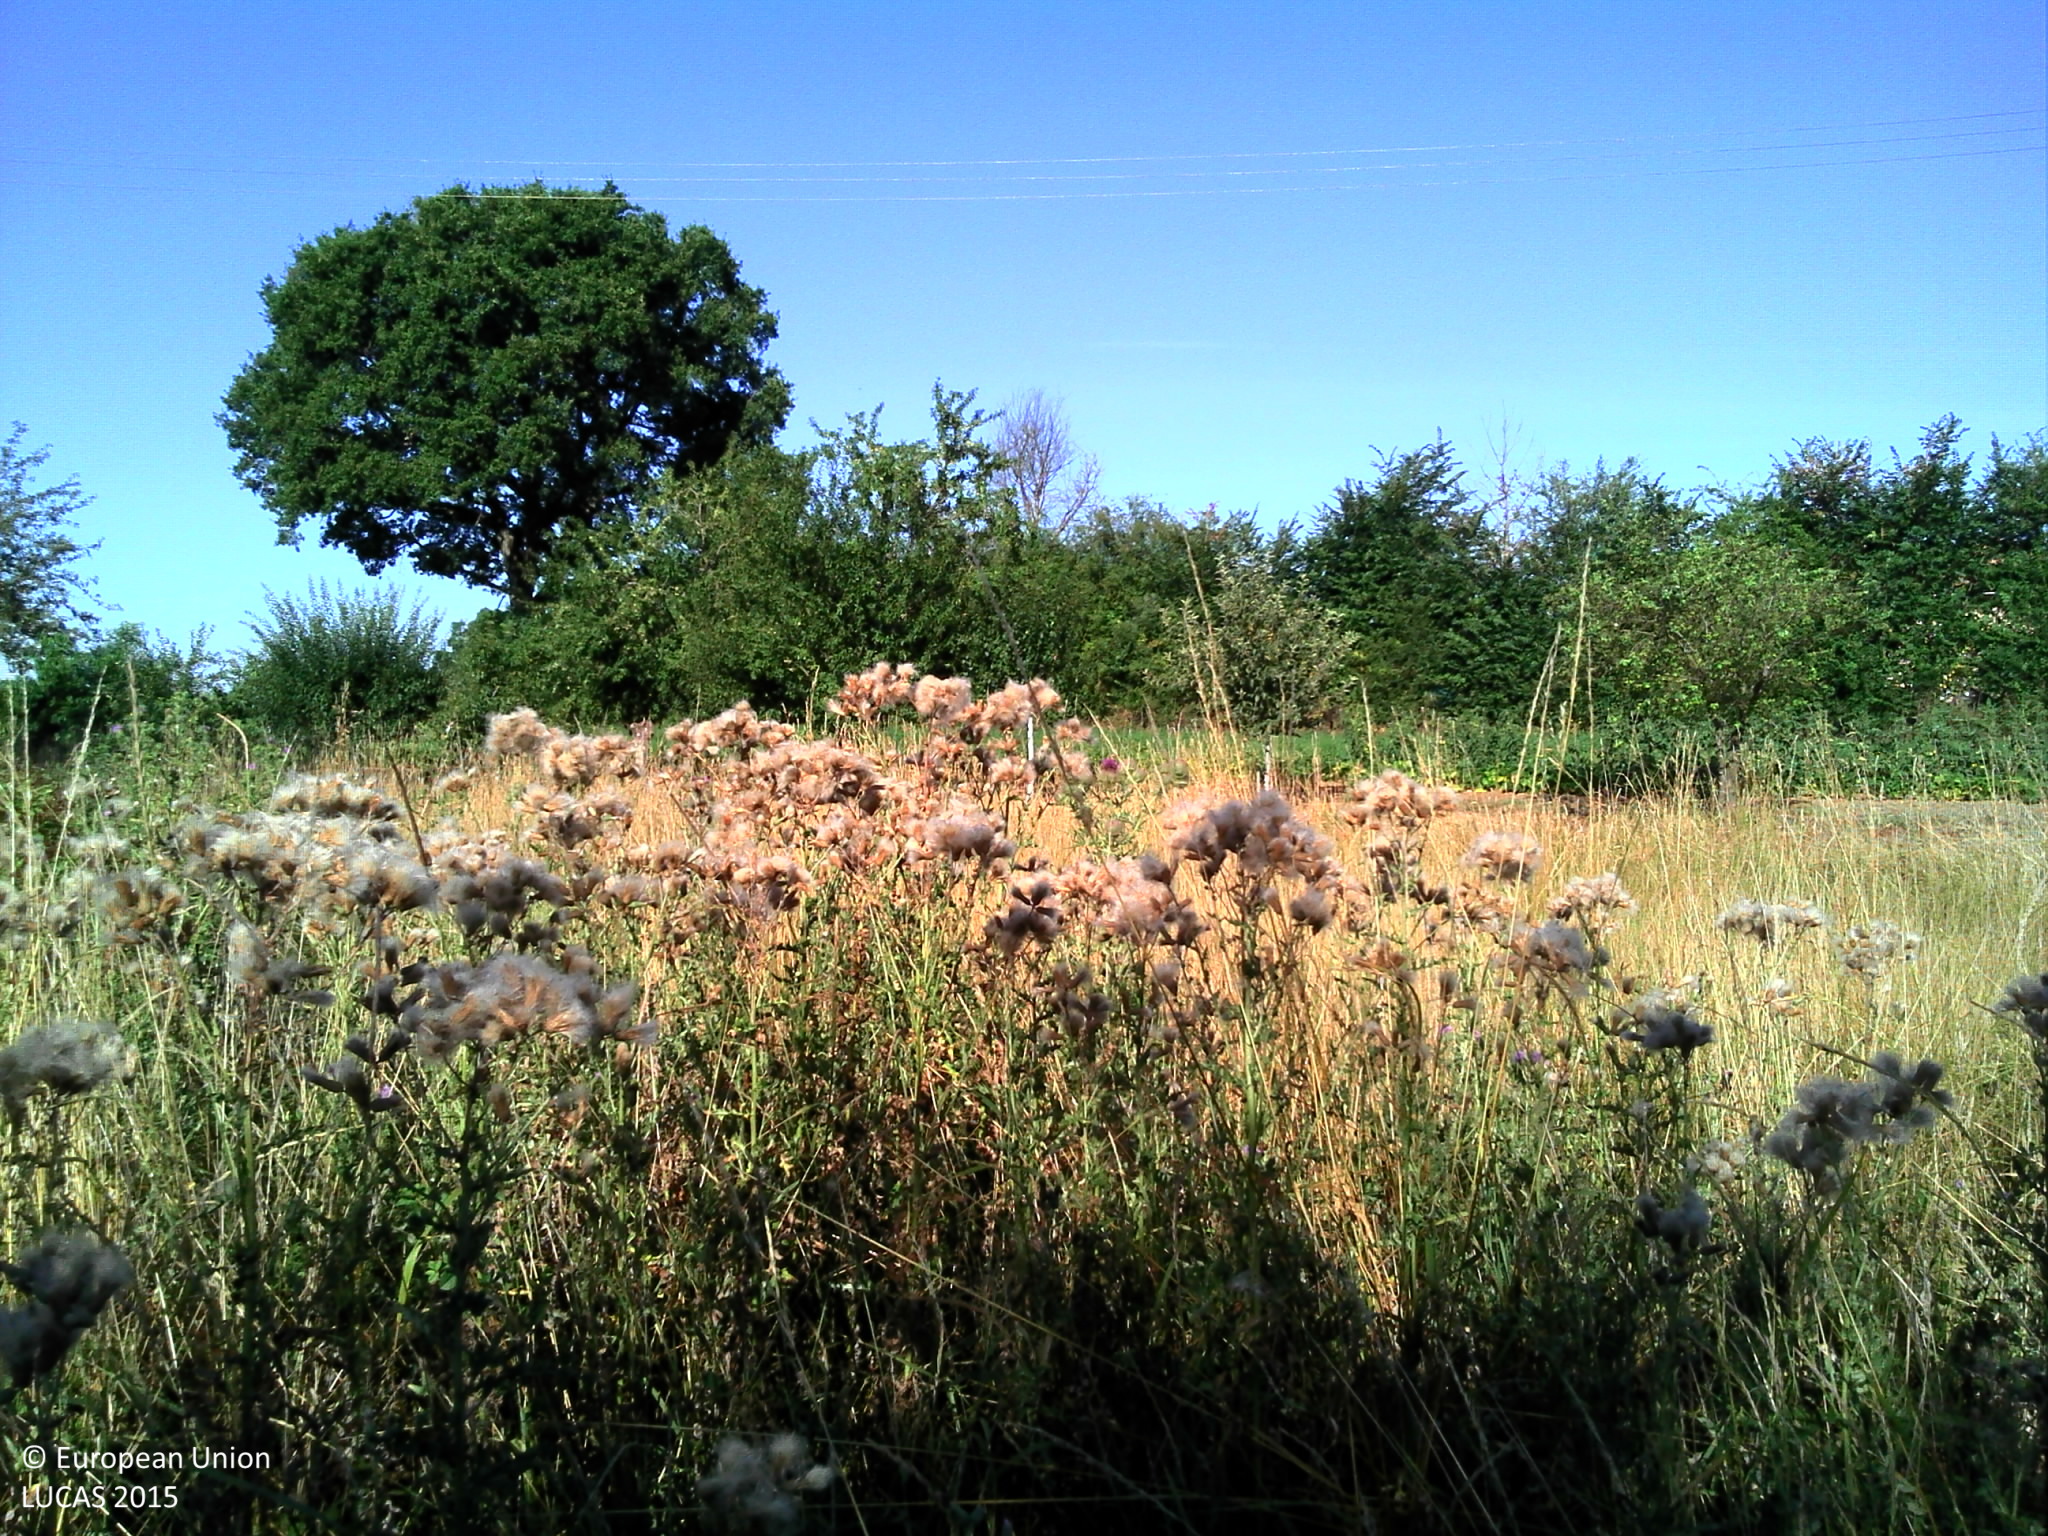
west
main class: Grassland
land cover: Grassland with sparse tree/shrub cover
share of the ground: > 75 %
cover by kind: herbaceous plants 95 %, broadleaved forest trees 5 %
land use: Residential
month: July
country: FR
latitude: 46.3789
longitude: 0.4789
